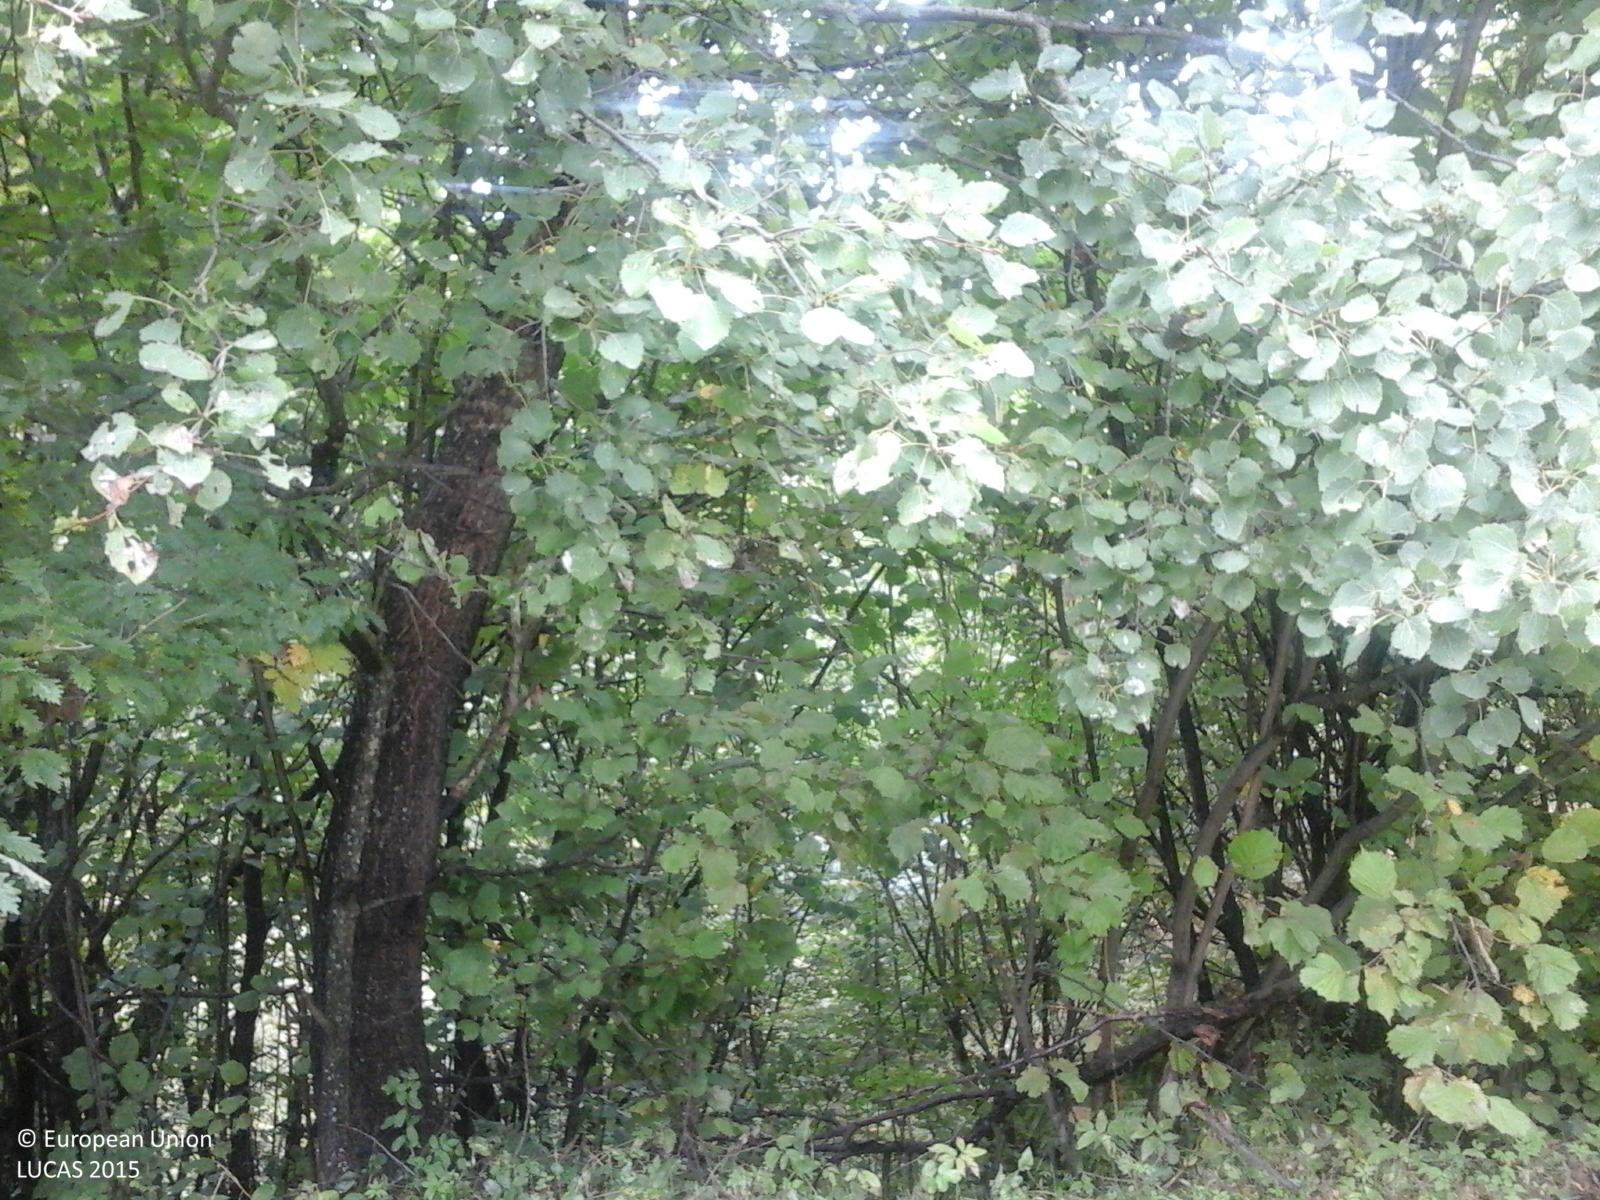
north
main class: Grassland
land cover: Grassland with sparse tree/shrub cover
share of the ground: > 75 %
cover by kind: herbaceous plants 85 %, shrubs 10 %, broadleaved forest trees 5 %
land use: Agriculture (excluding fallow land and kitchen gardens)
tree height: < 5 m
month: September
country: RO
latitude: 45.8023
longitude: 23.7709
